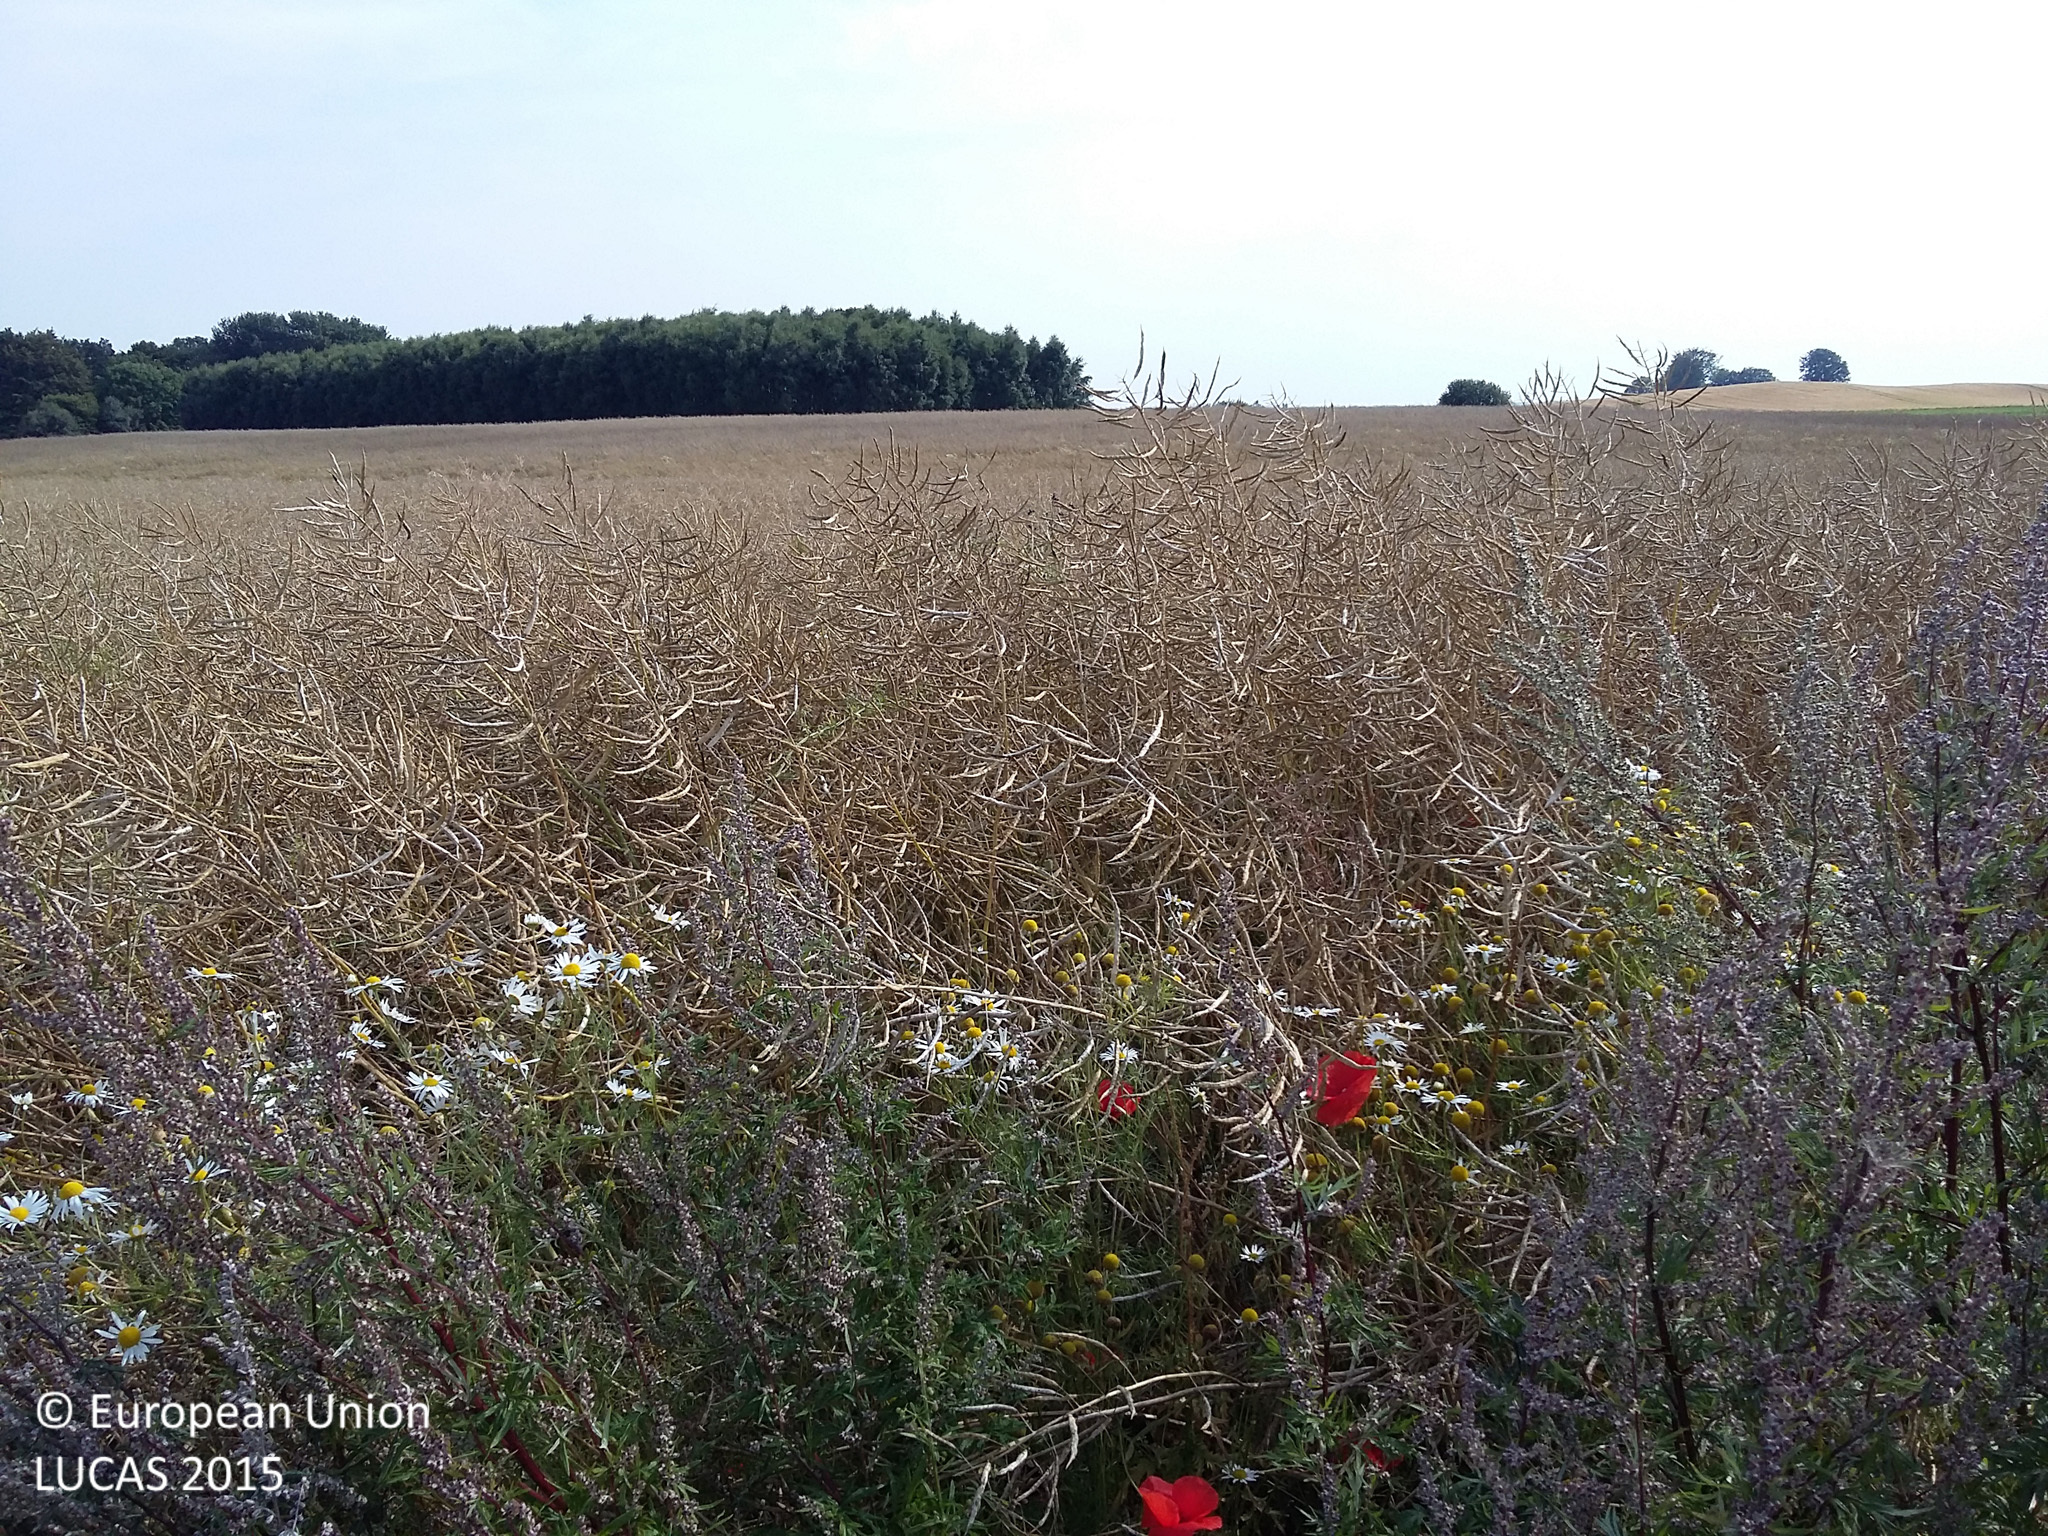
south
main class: Cropland
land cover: Rape and turnip rape
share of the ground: > 75 %
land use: Agriculture (excluding fallow land and kitchen gardens)
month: August
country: DK
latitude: 55.5082
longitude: 11.9143
